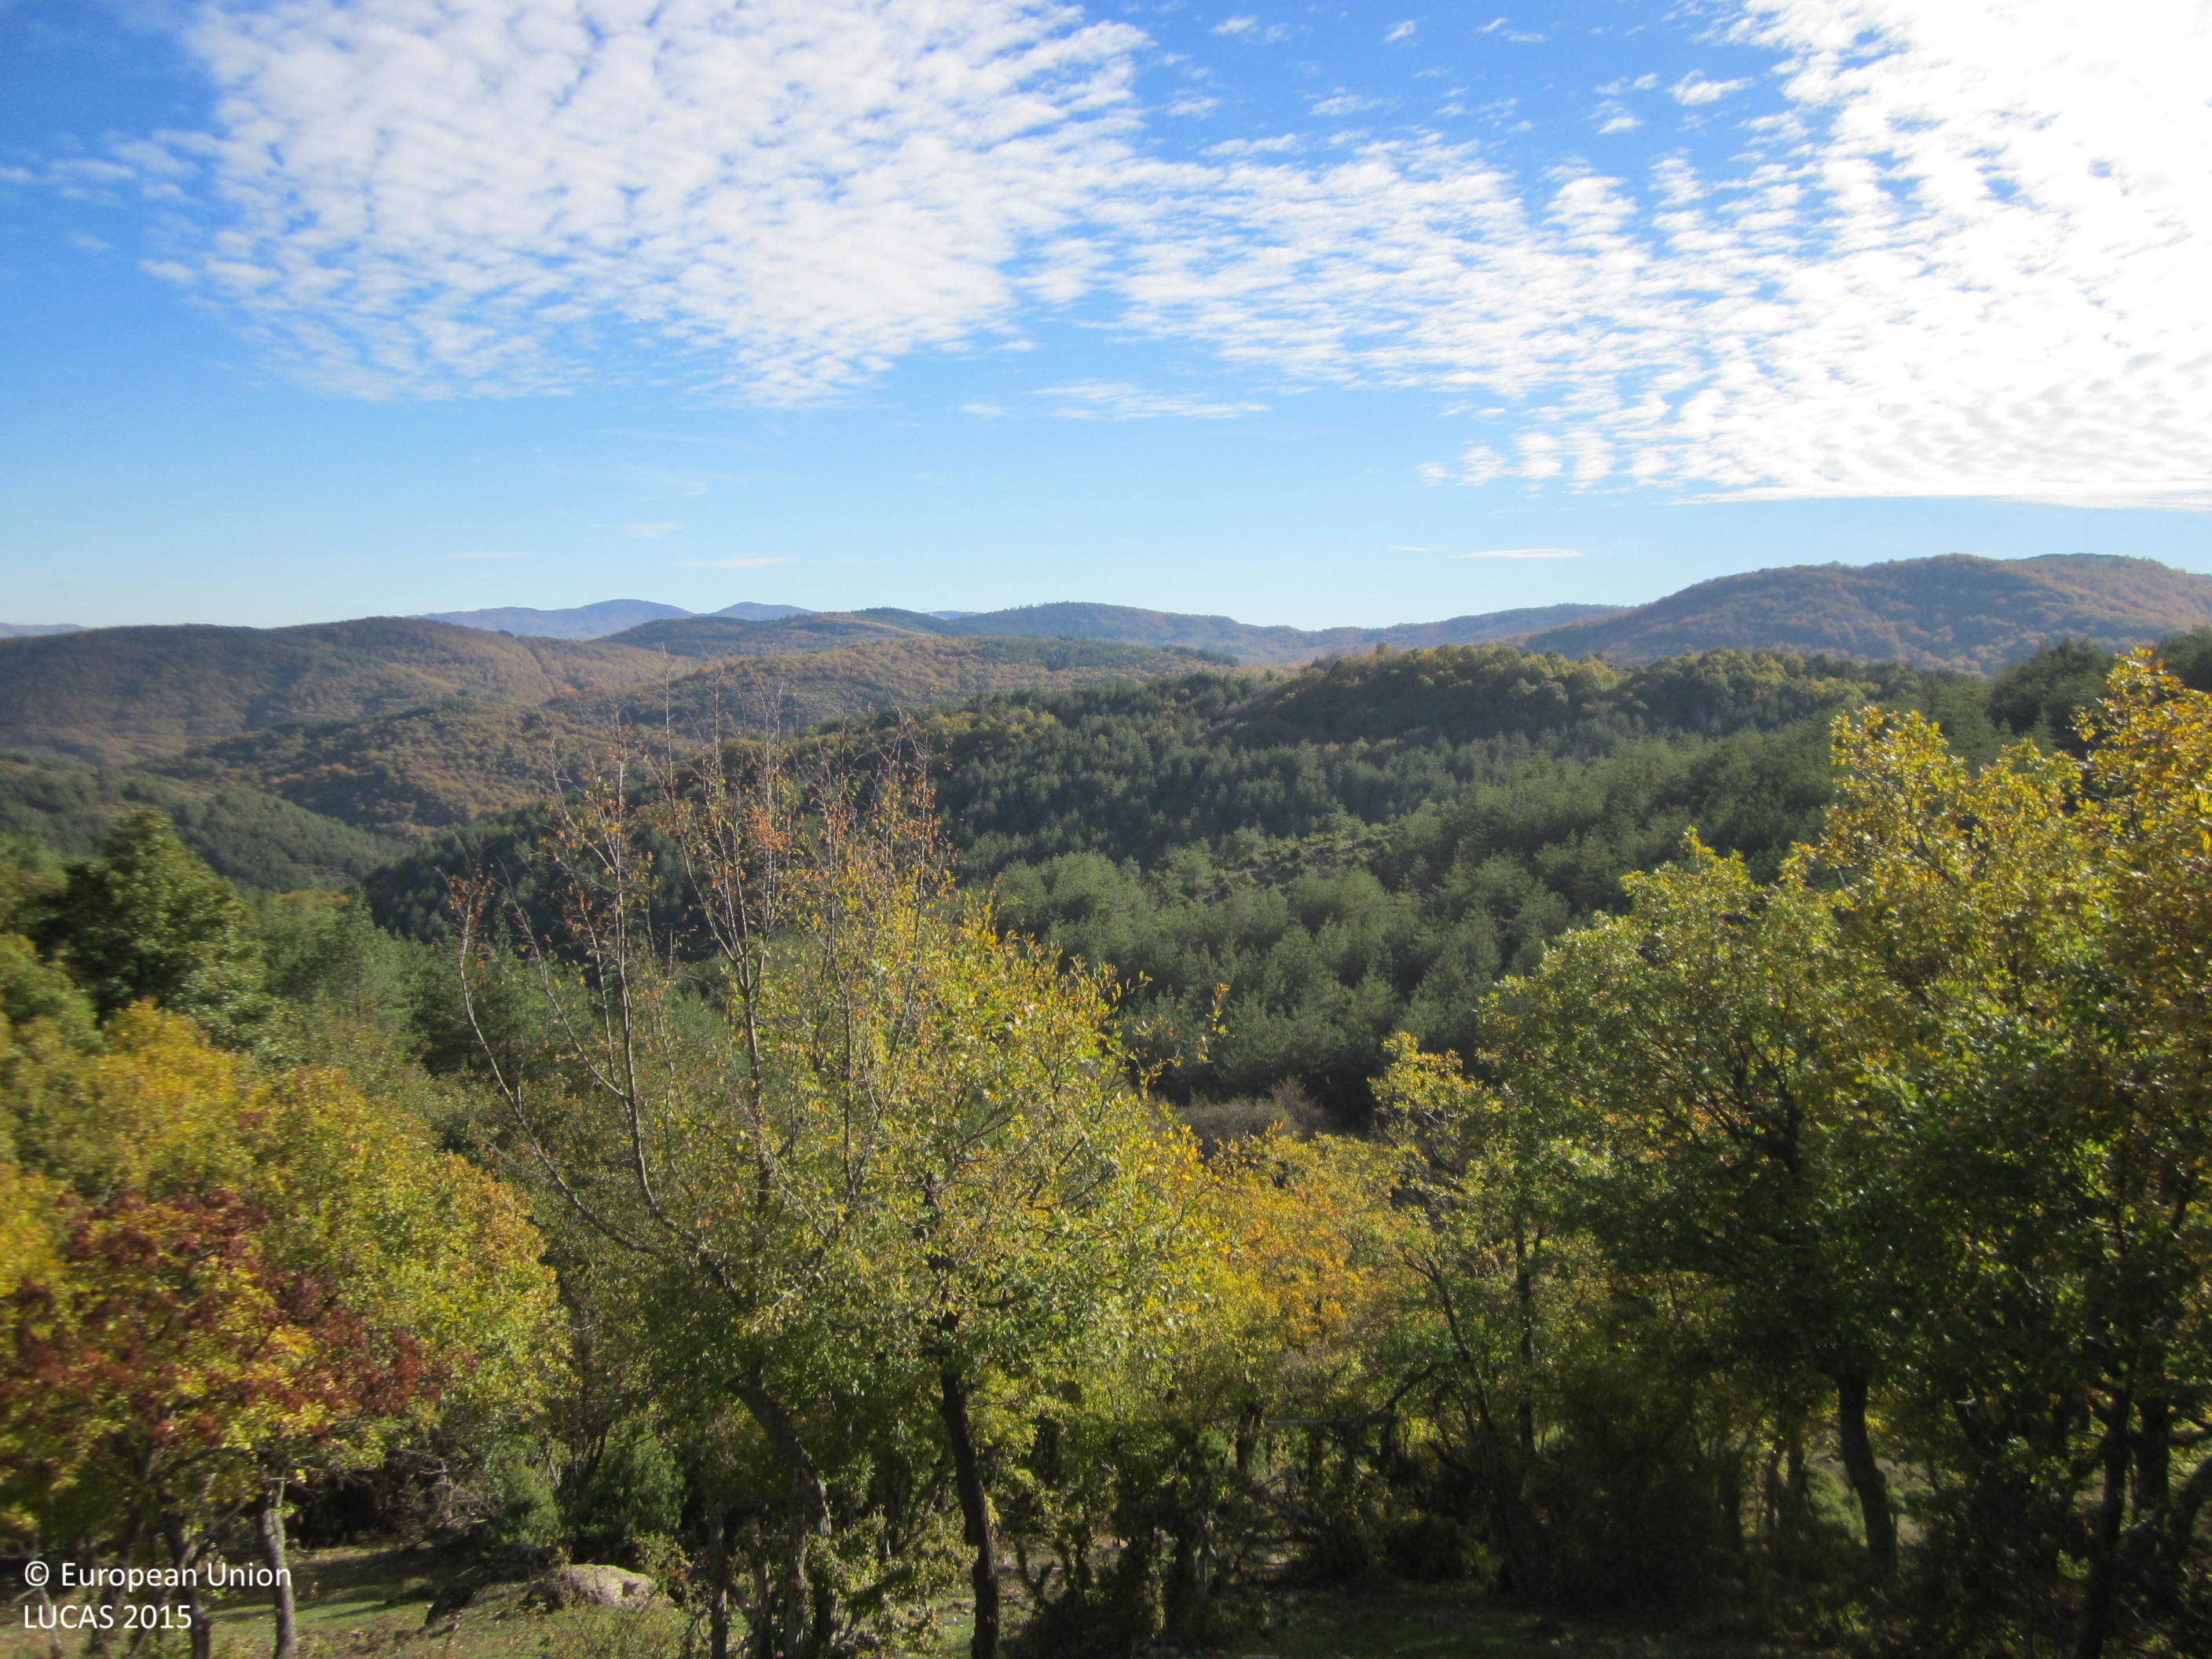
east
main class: Woodland
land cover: Pine dominated coniferous woodland
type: acidophilous oak and oak-birch forest
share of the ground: > 75 %
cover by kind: coniferous forest trees 100 %
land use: Forestry
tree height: > 5 m
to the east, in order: Pine dominated coniferous woodland; Pine dominated mixed woodland; Shrubland with sparse tree cover; Broadleaved woodland
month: November
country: BG
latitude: 41.3151
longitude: 25.6713
